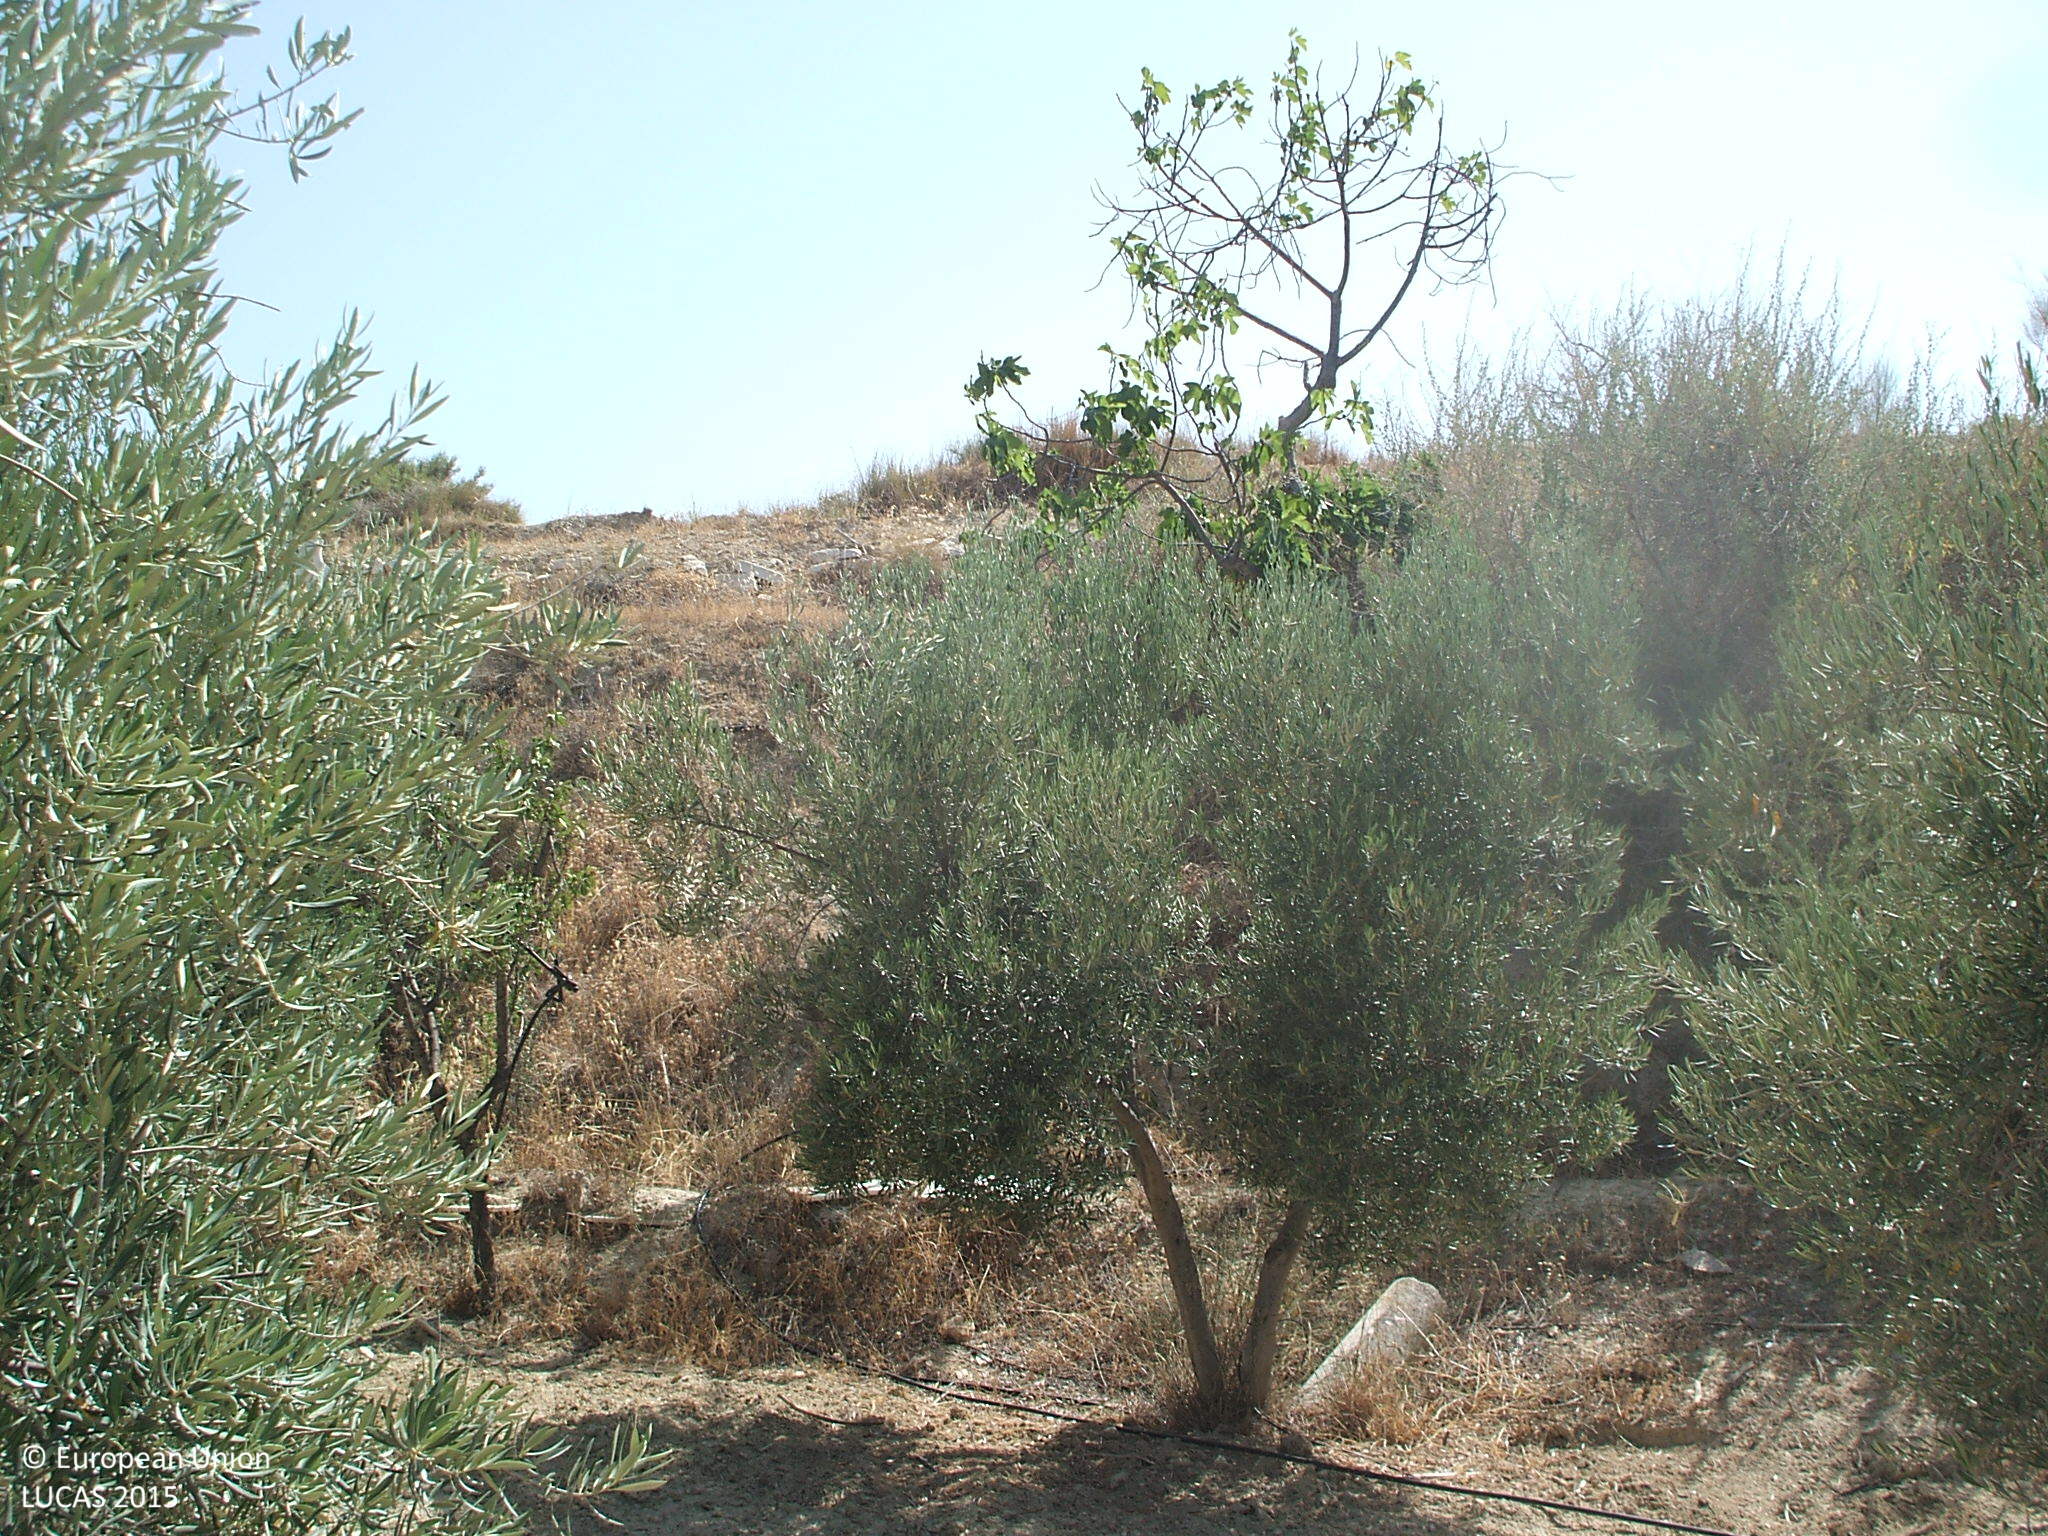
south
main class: Cropland
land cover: Olive groves
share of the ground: 50 - 75 %
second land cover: Other bare soil
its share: > 75 %
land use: Agriculture (excluding fallow land and kitchen gardens)
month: July
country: ES
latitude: 37.3821
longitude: -2.3264
